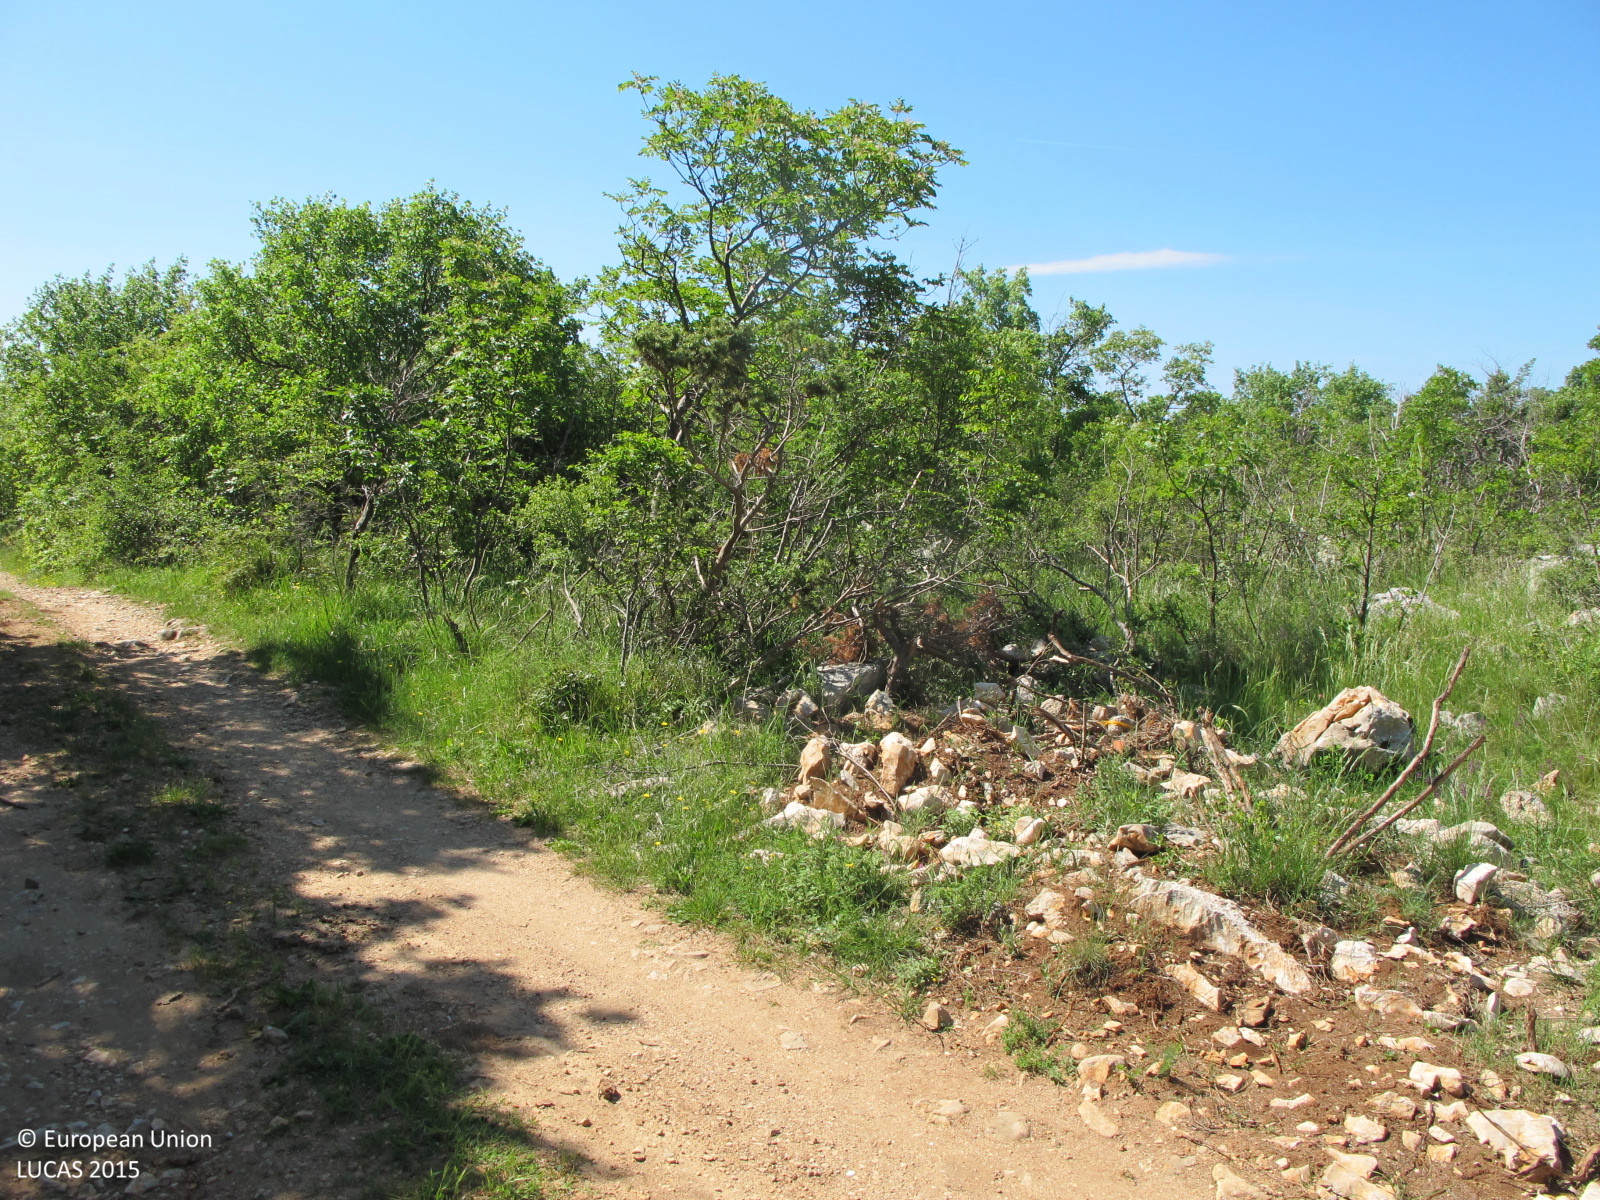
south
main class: Shrubland
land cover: Shrubland with sparse tree cover
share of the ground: > 75 %
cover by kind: shrubs 90 %, broadleaved forest trees 5 %, herbaceous plants 5 %
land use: Semi-natural and natural areas not in use
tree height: < 5 m
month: May
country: HR
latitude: 45.1419
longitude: 14.8145
